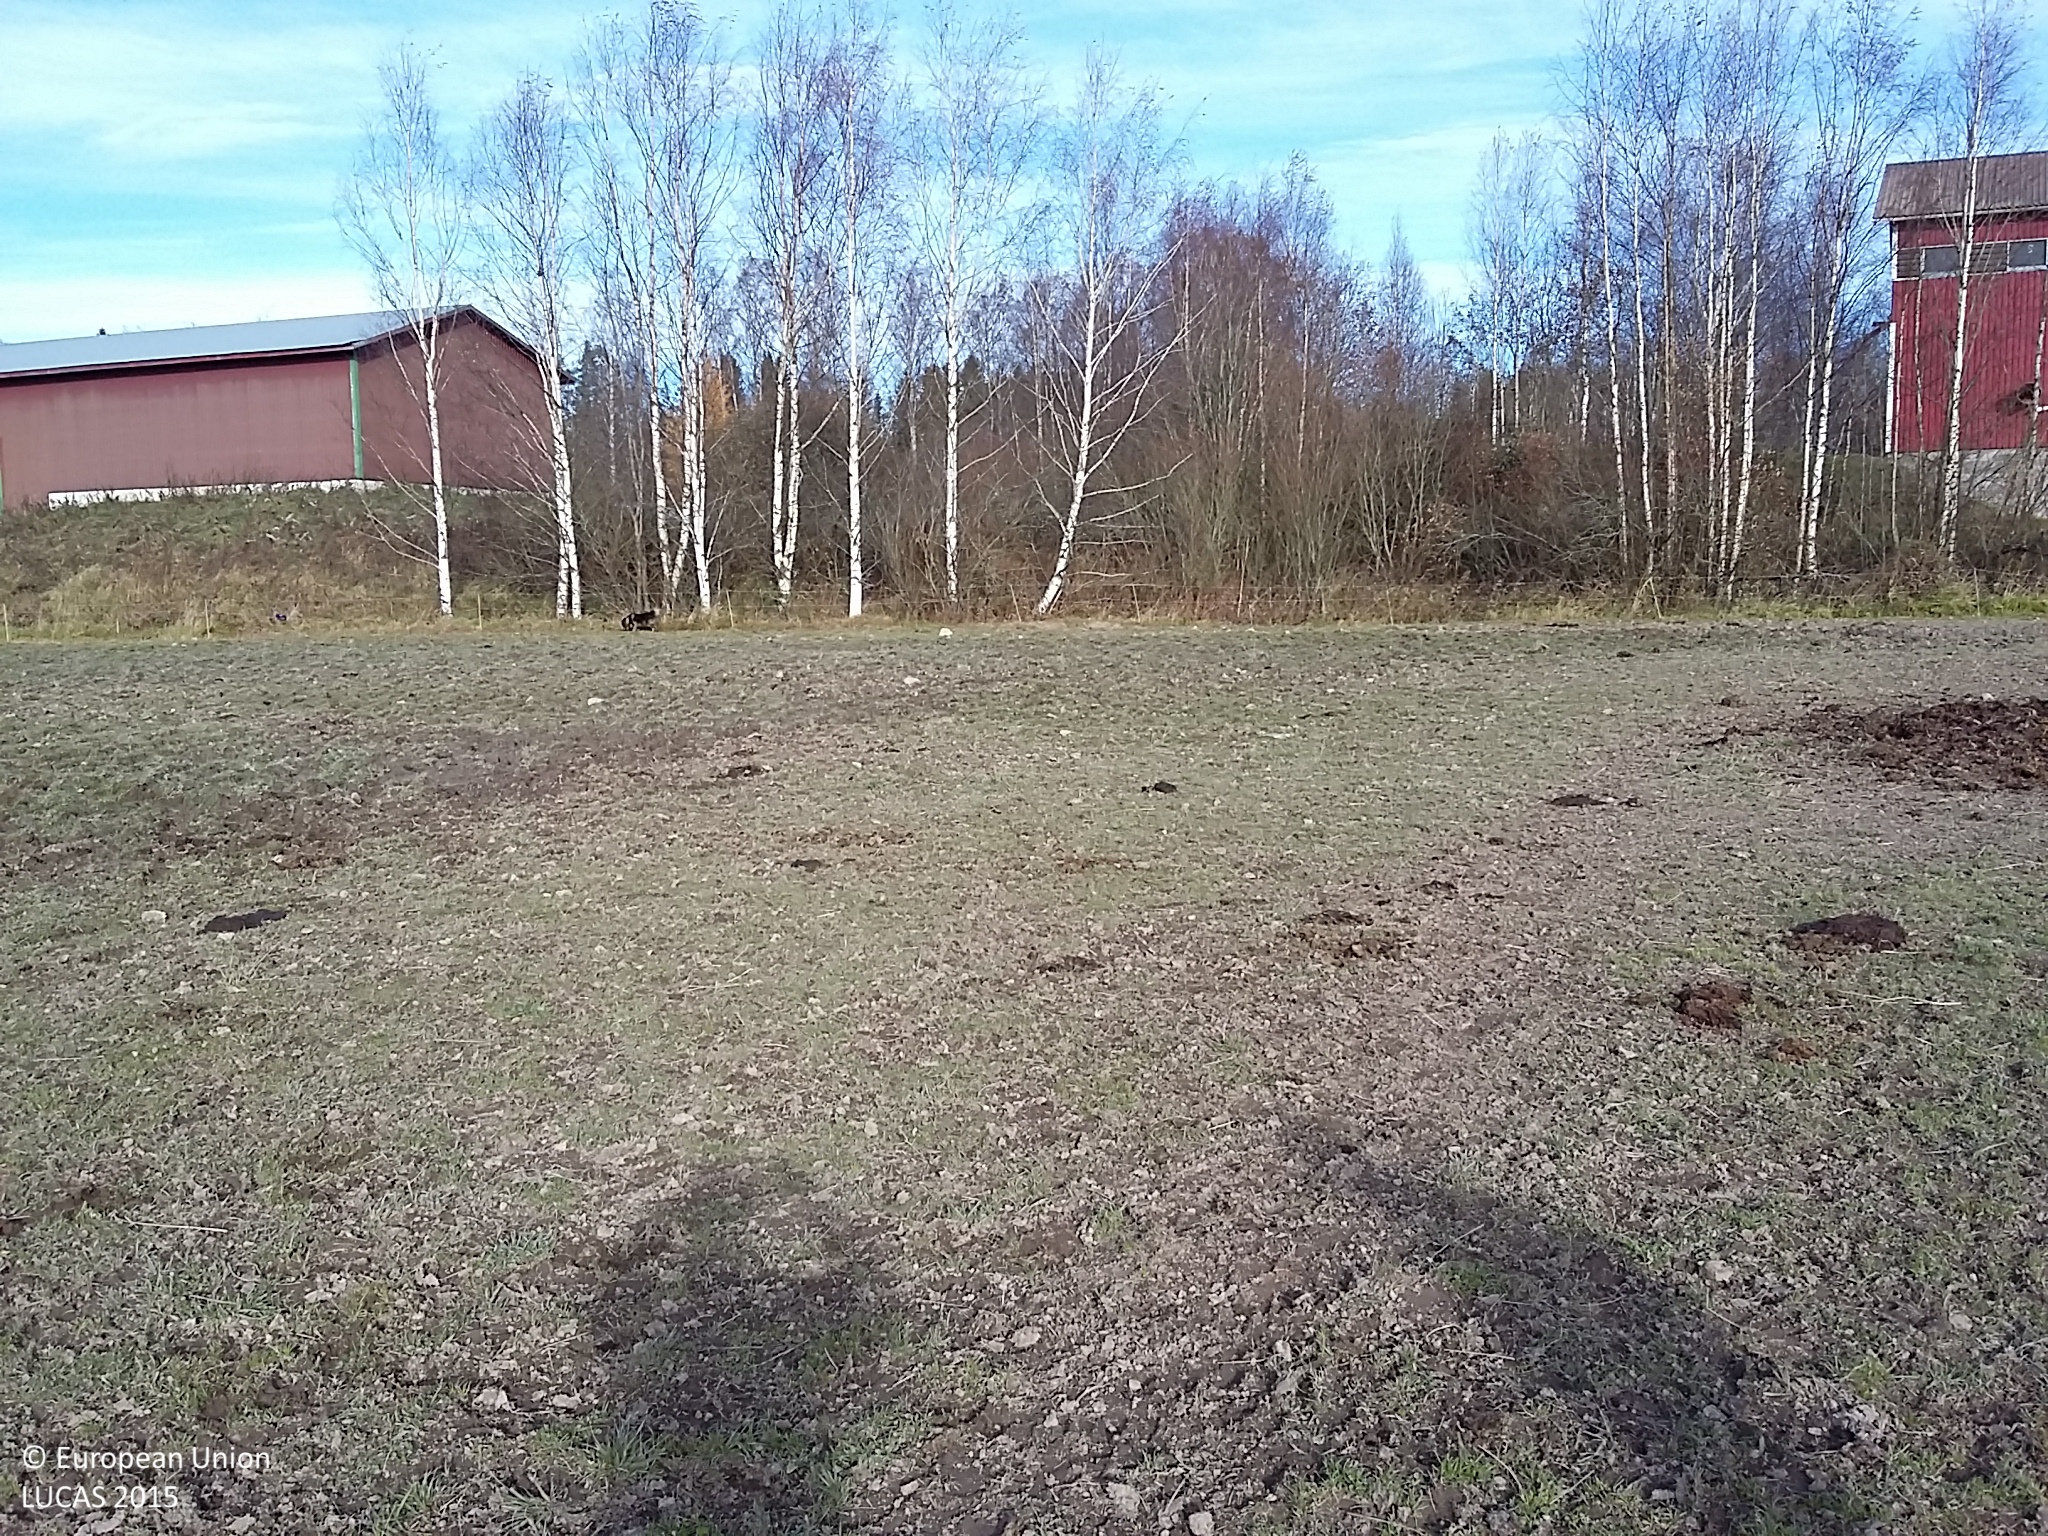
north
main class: Grassland
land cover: Grassland without tree/shrub cover
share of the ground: > 75 %
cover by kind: herbaceous plants 100 %
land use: Agriculture (excluding fallow land and kitchen gardens)
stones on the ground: < 10 %
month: October
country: FI
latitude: 63.8776
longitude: 25.0495
